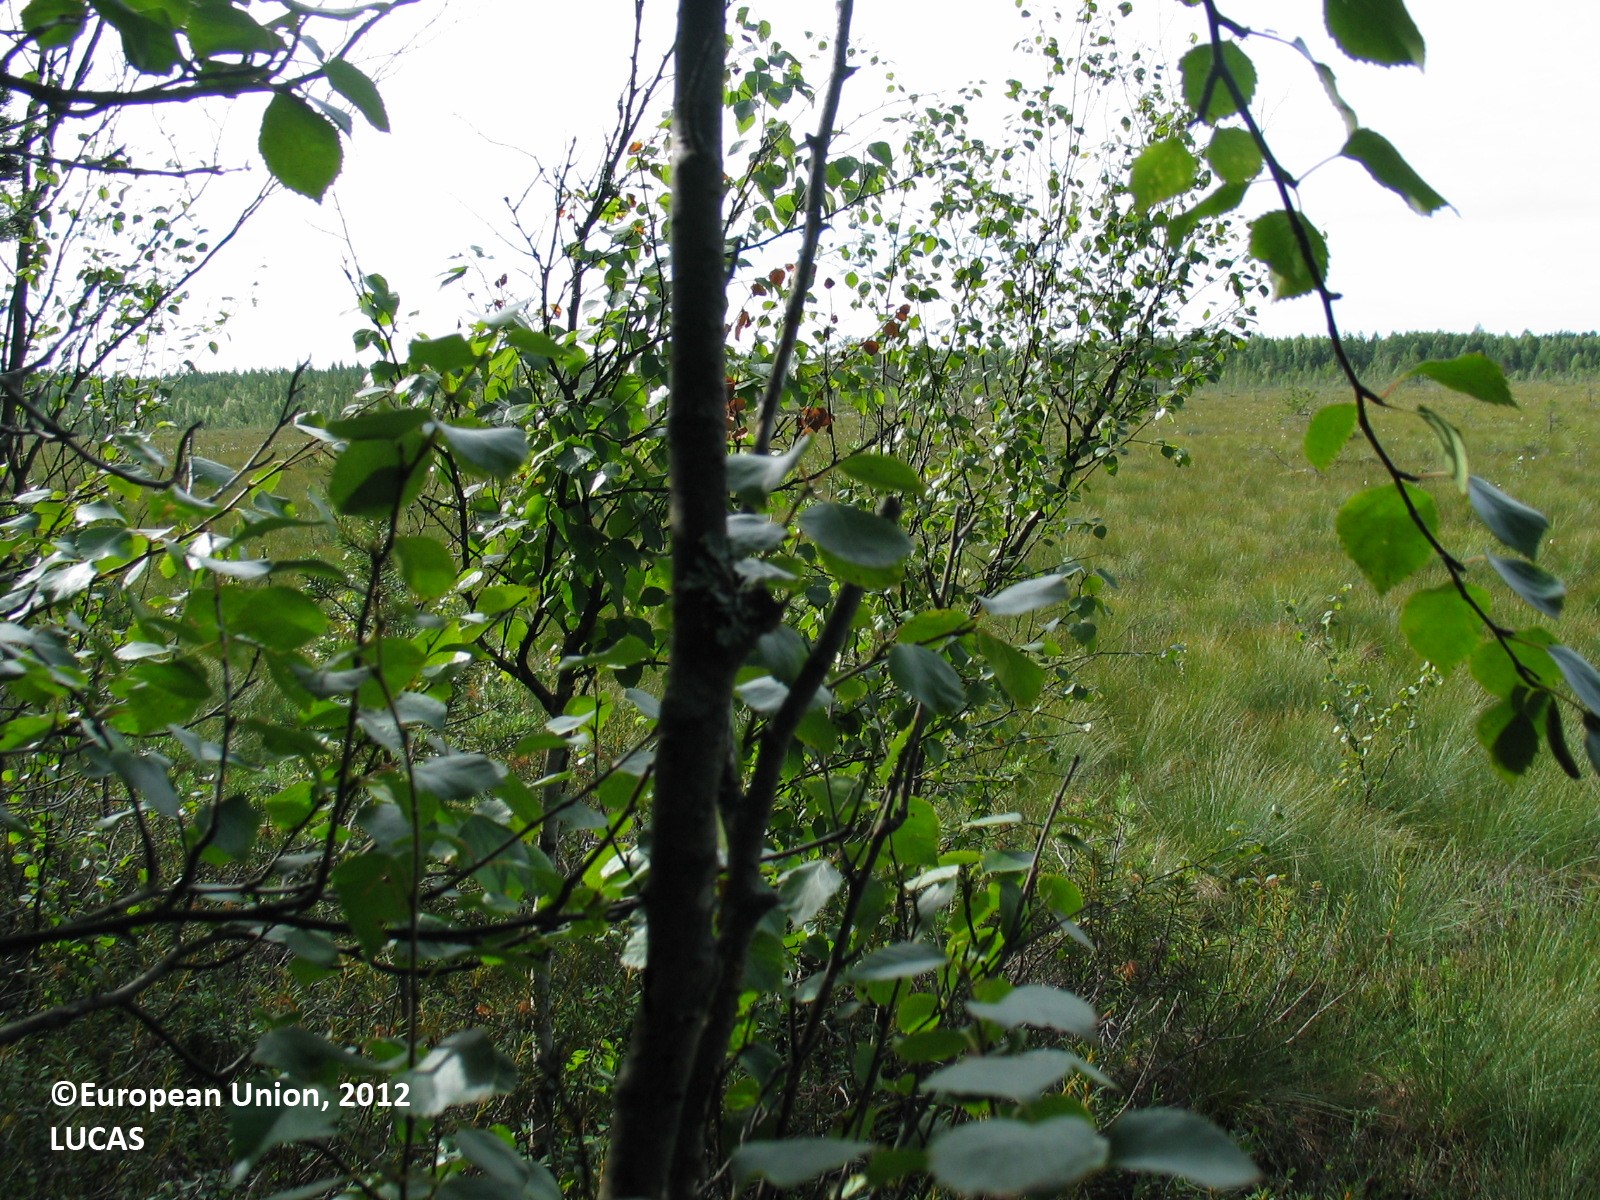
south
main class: Woodland
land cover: Other mixed woodland
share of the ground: 50 - 75 %
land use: Forestry
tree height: > 5 m
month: July
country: FI
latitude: 64.6685
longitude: 26.3856
